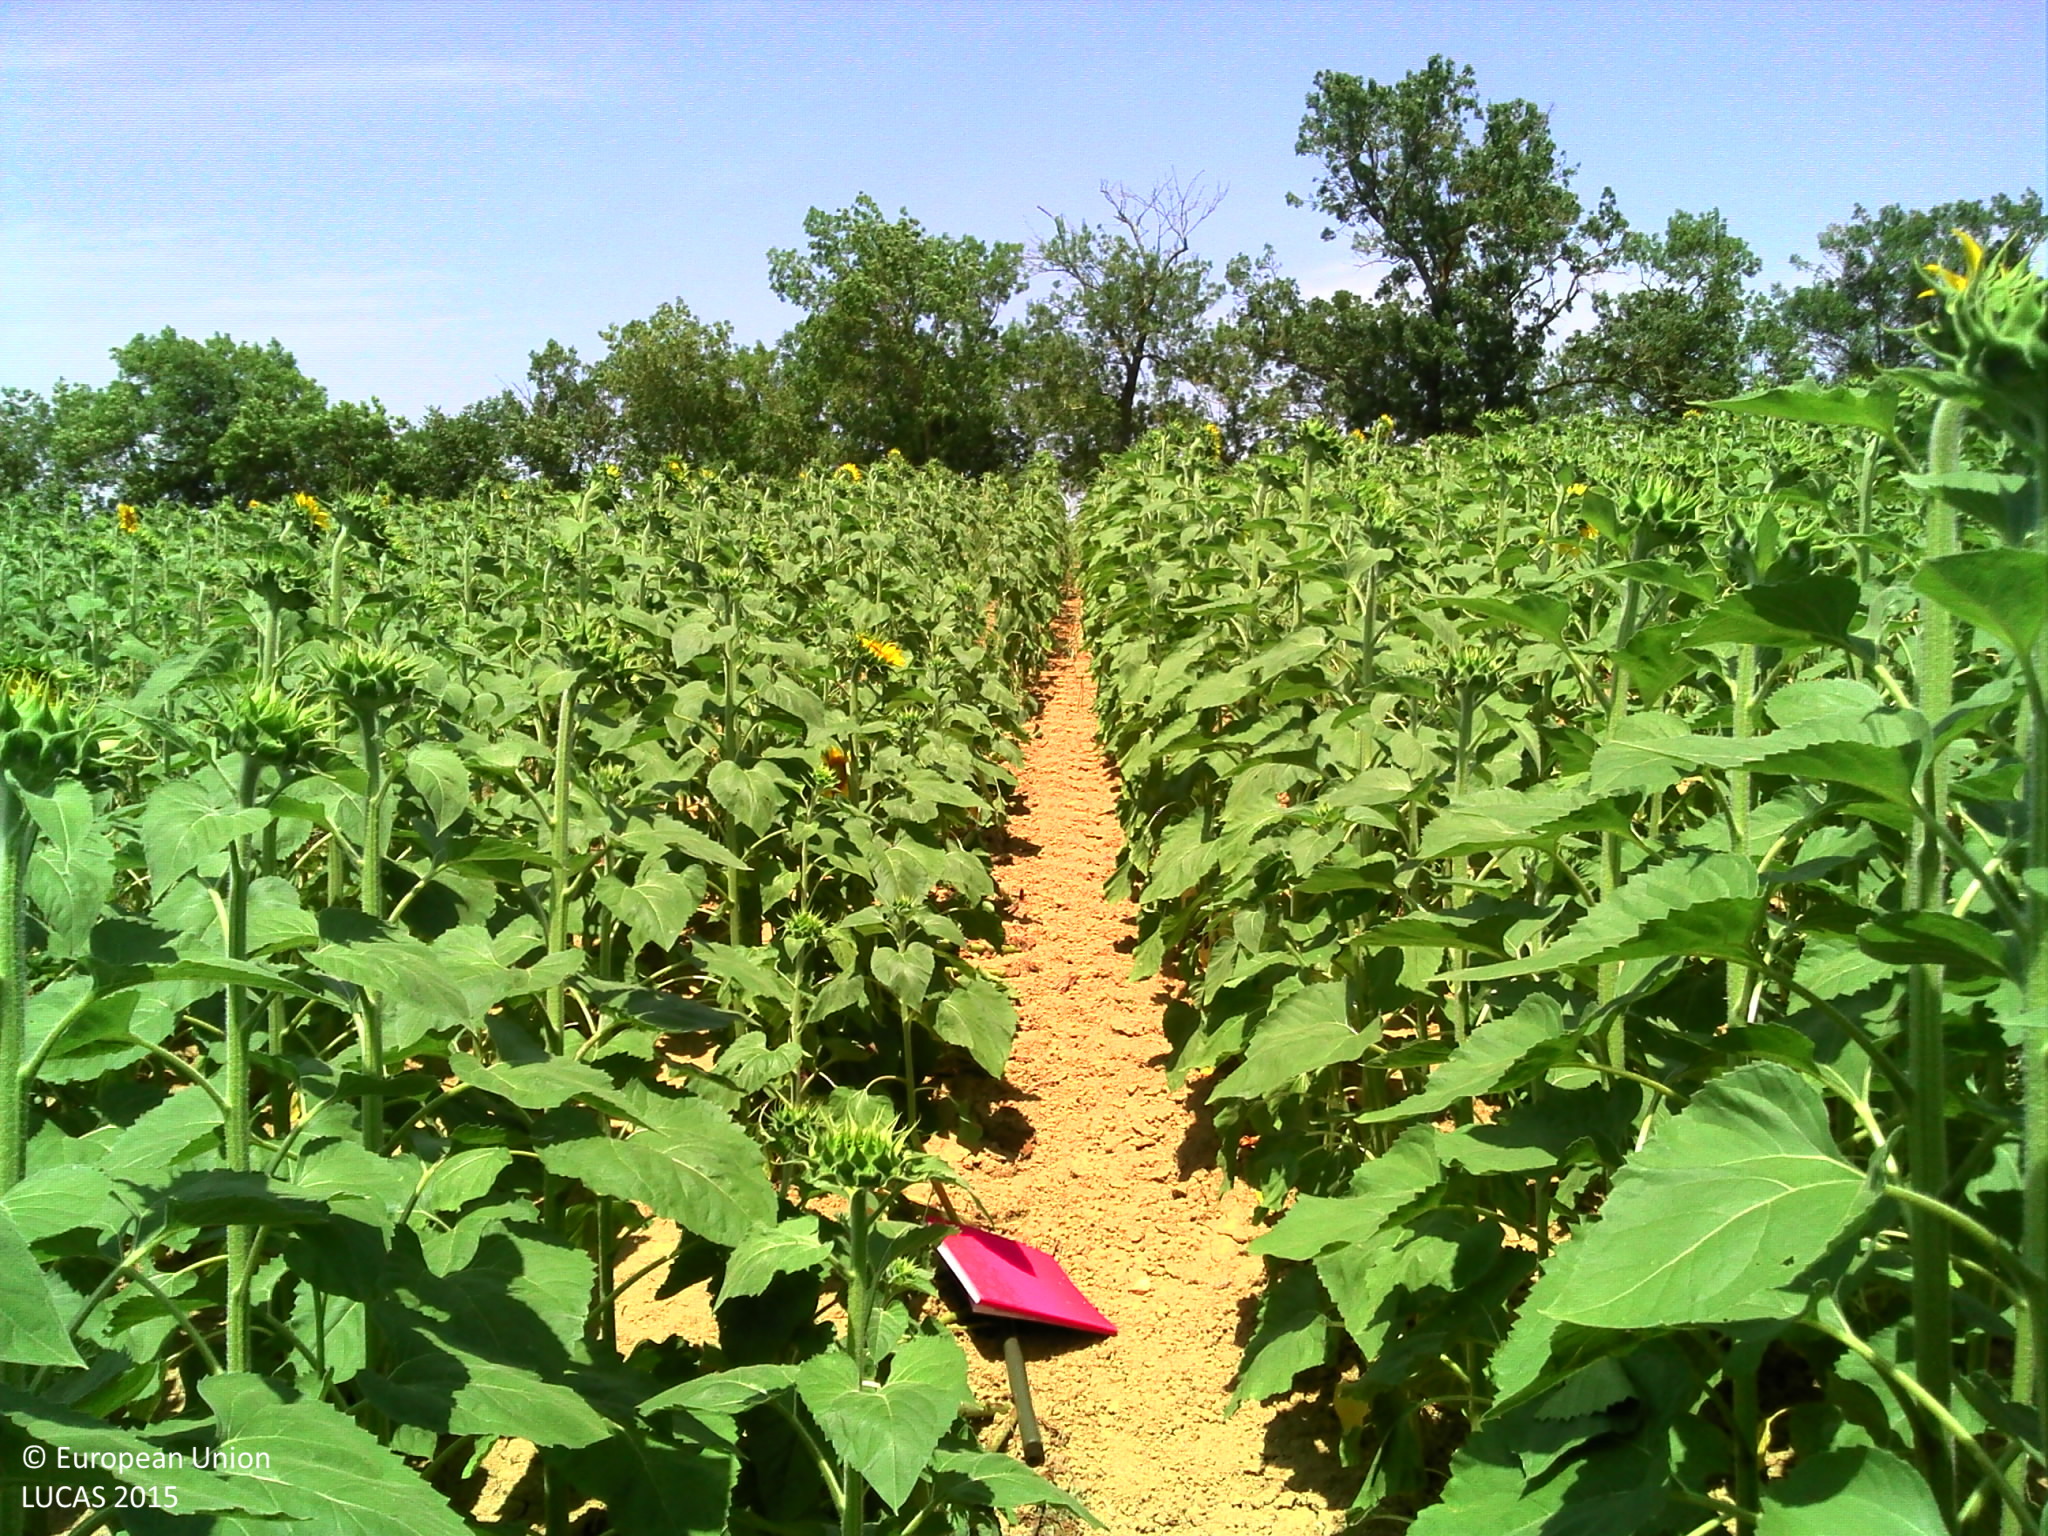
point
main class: Cropland
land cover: Sunflower
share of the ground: > 75 %
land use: Agriculture (excluding fallow land and kitchen gardens)
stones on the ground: < 10 %
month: July
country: FR
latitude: 43.4881
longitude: 1.0117
